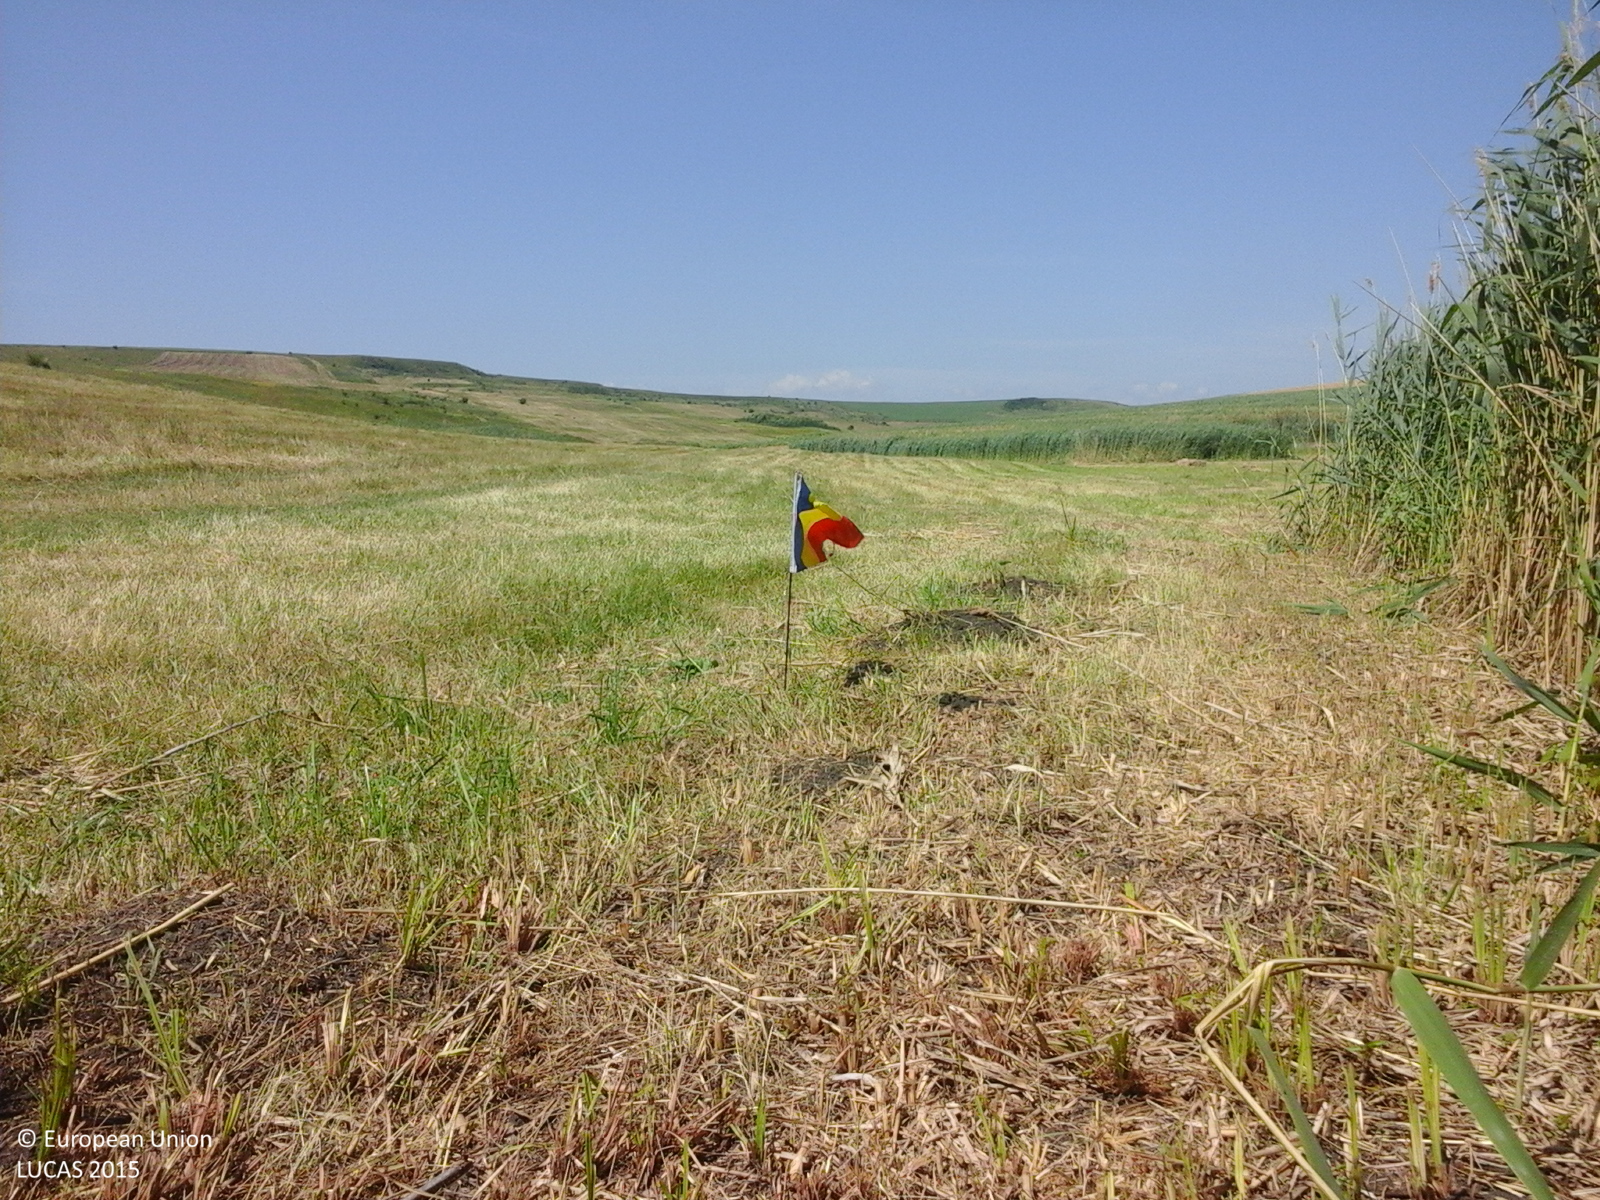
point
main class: Grassland
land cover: Grassland without tree/shrub cover
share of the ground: > 75 %
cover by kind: herbaceous plants 100 %
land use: Agriculture (excluding fallow land and kitchen gardens)
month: June
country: RO
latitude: 47.6546
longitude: 27.1646
